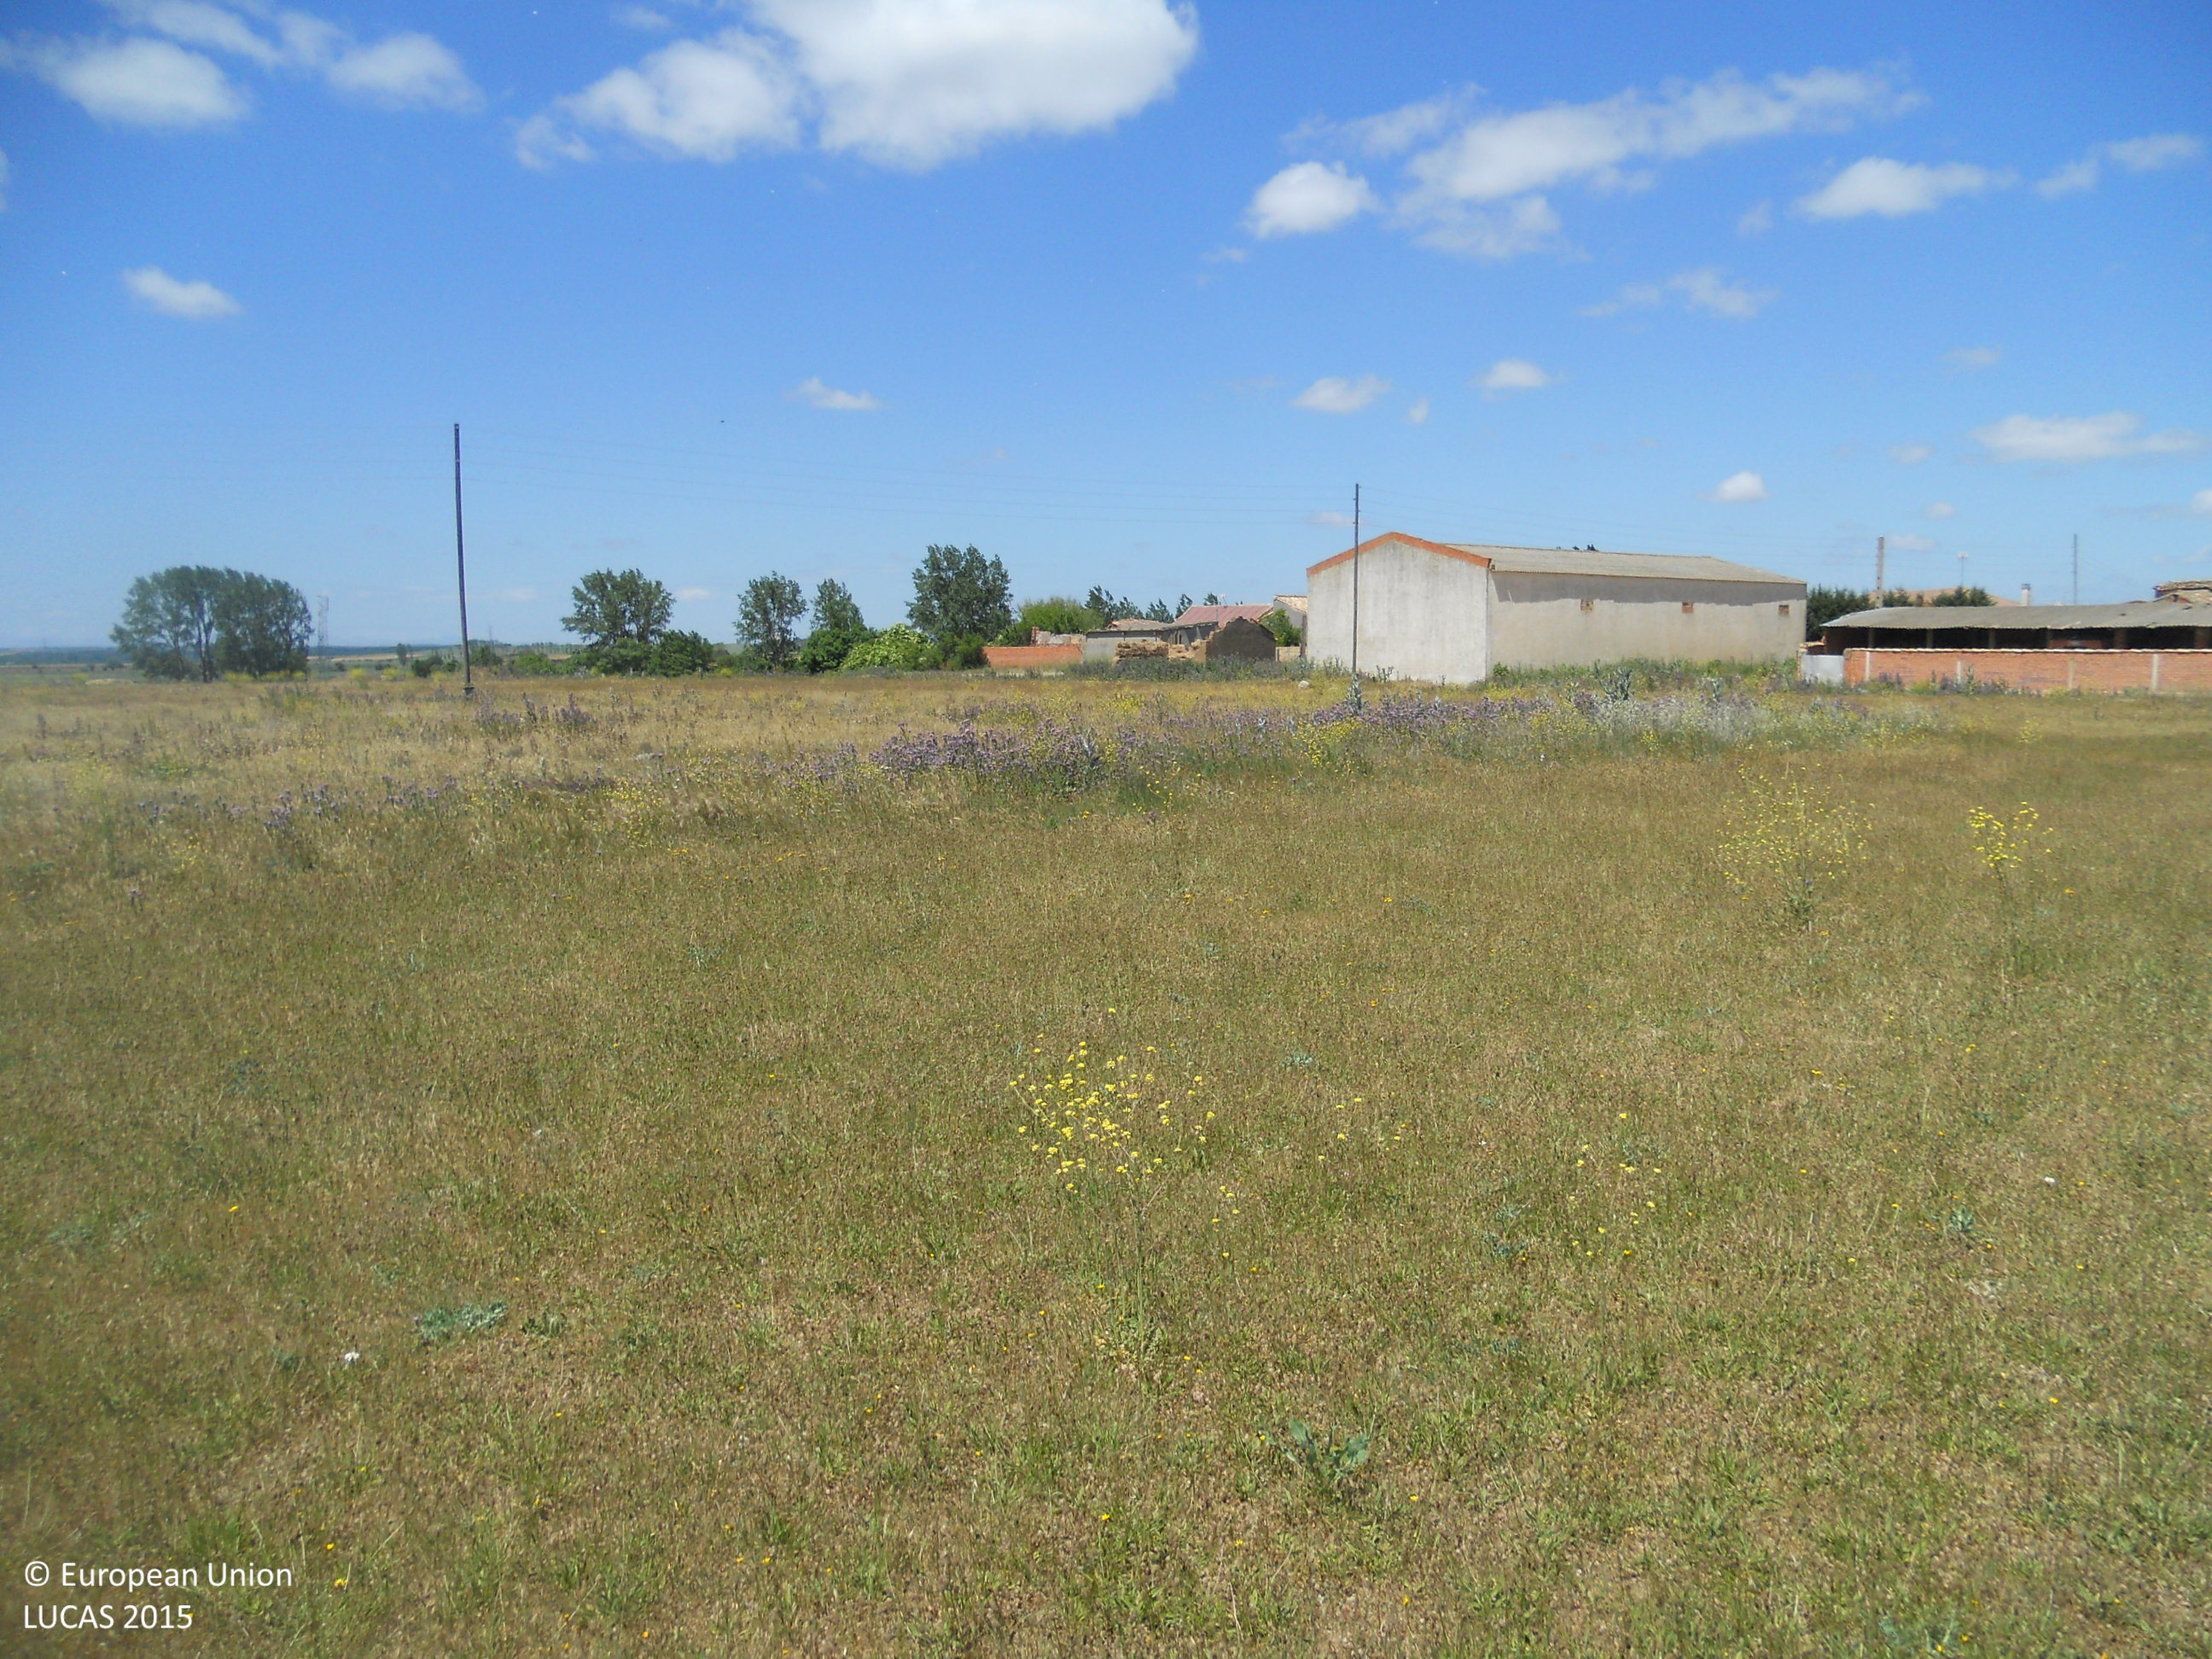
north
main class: Grassland
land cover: Grassland without tree/shrub cover
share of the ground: > 75 %
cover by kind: herbaceous plants 100 %
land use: Agriculture (excluding fallow land and kitchen gardens)
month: May
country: ES
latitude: 42.3565
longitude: -4.2376
